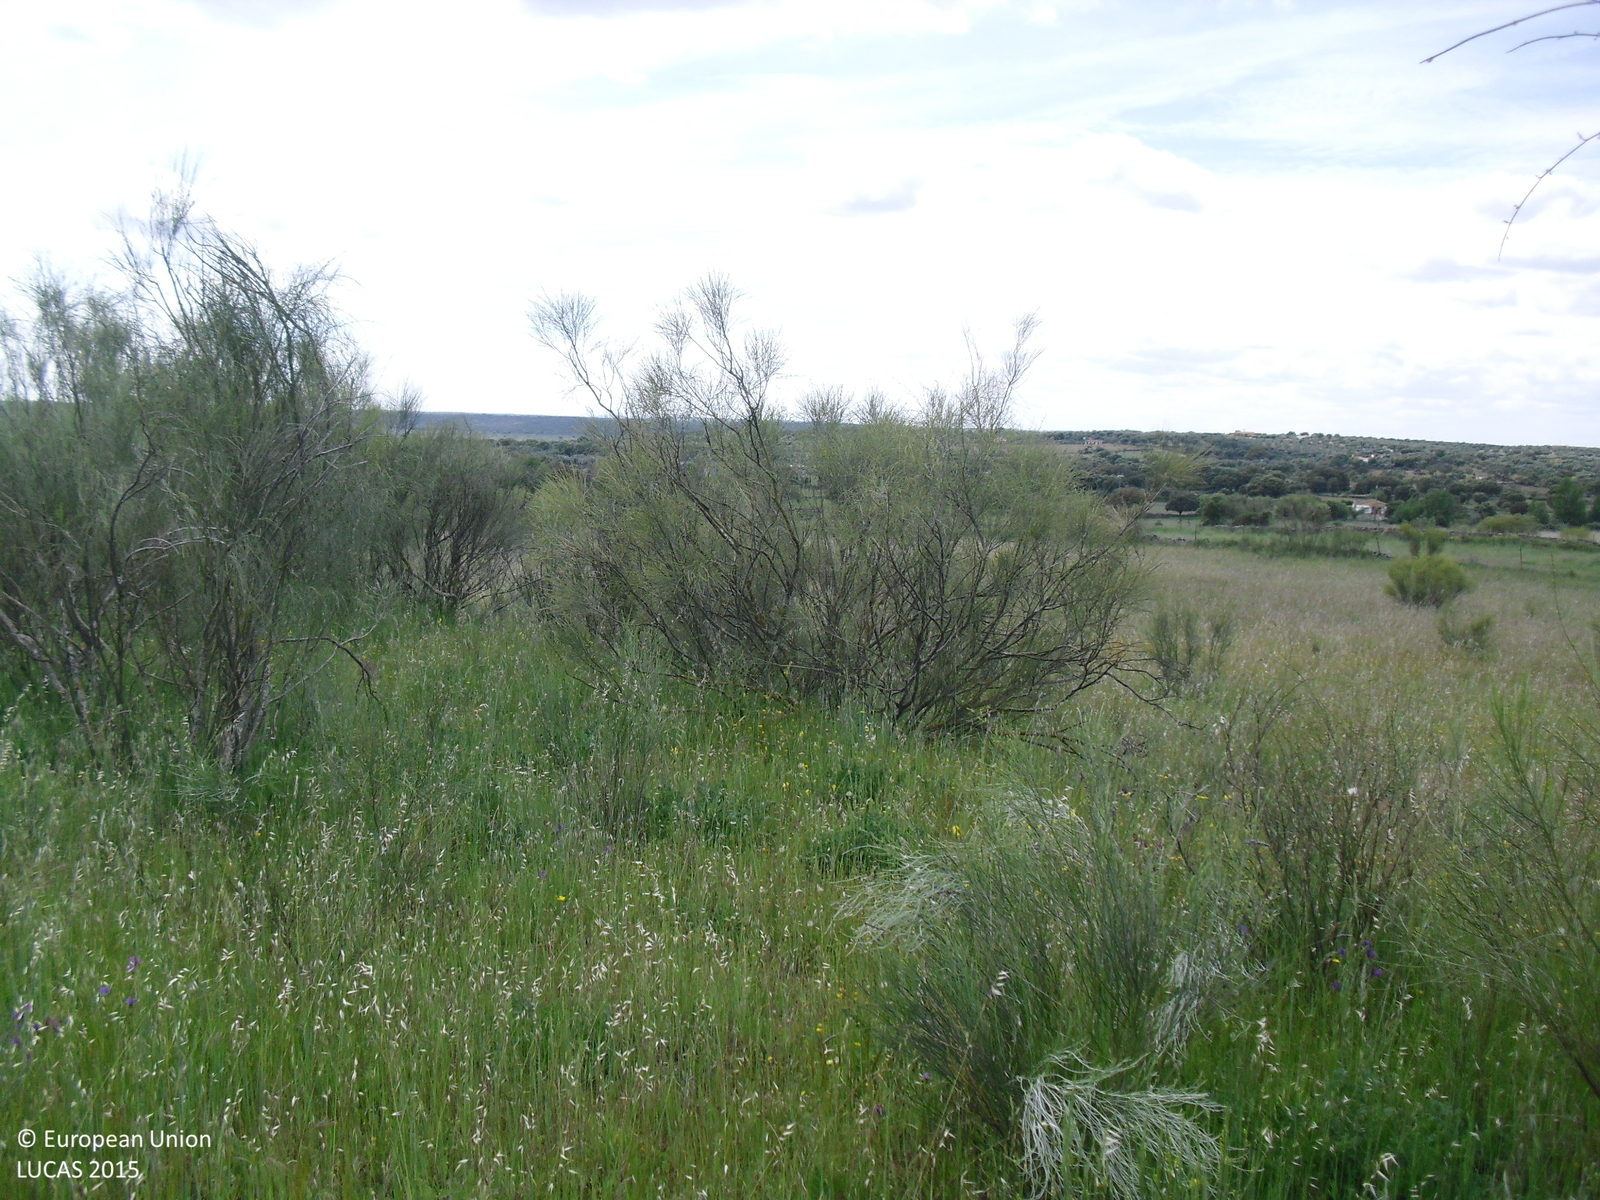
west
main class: Shrubland
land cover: Shrubland without tree cover
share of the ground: 10 - 25 %
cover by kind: herbaceous plants 90 %, shrubs 10 %
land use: Agriculture (excluding fallow land and kitchen gardens)
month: April
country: ES
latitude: 39.3081
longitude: -6.0276
